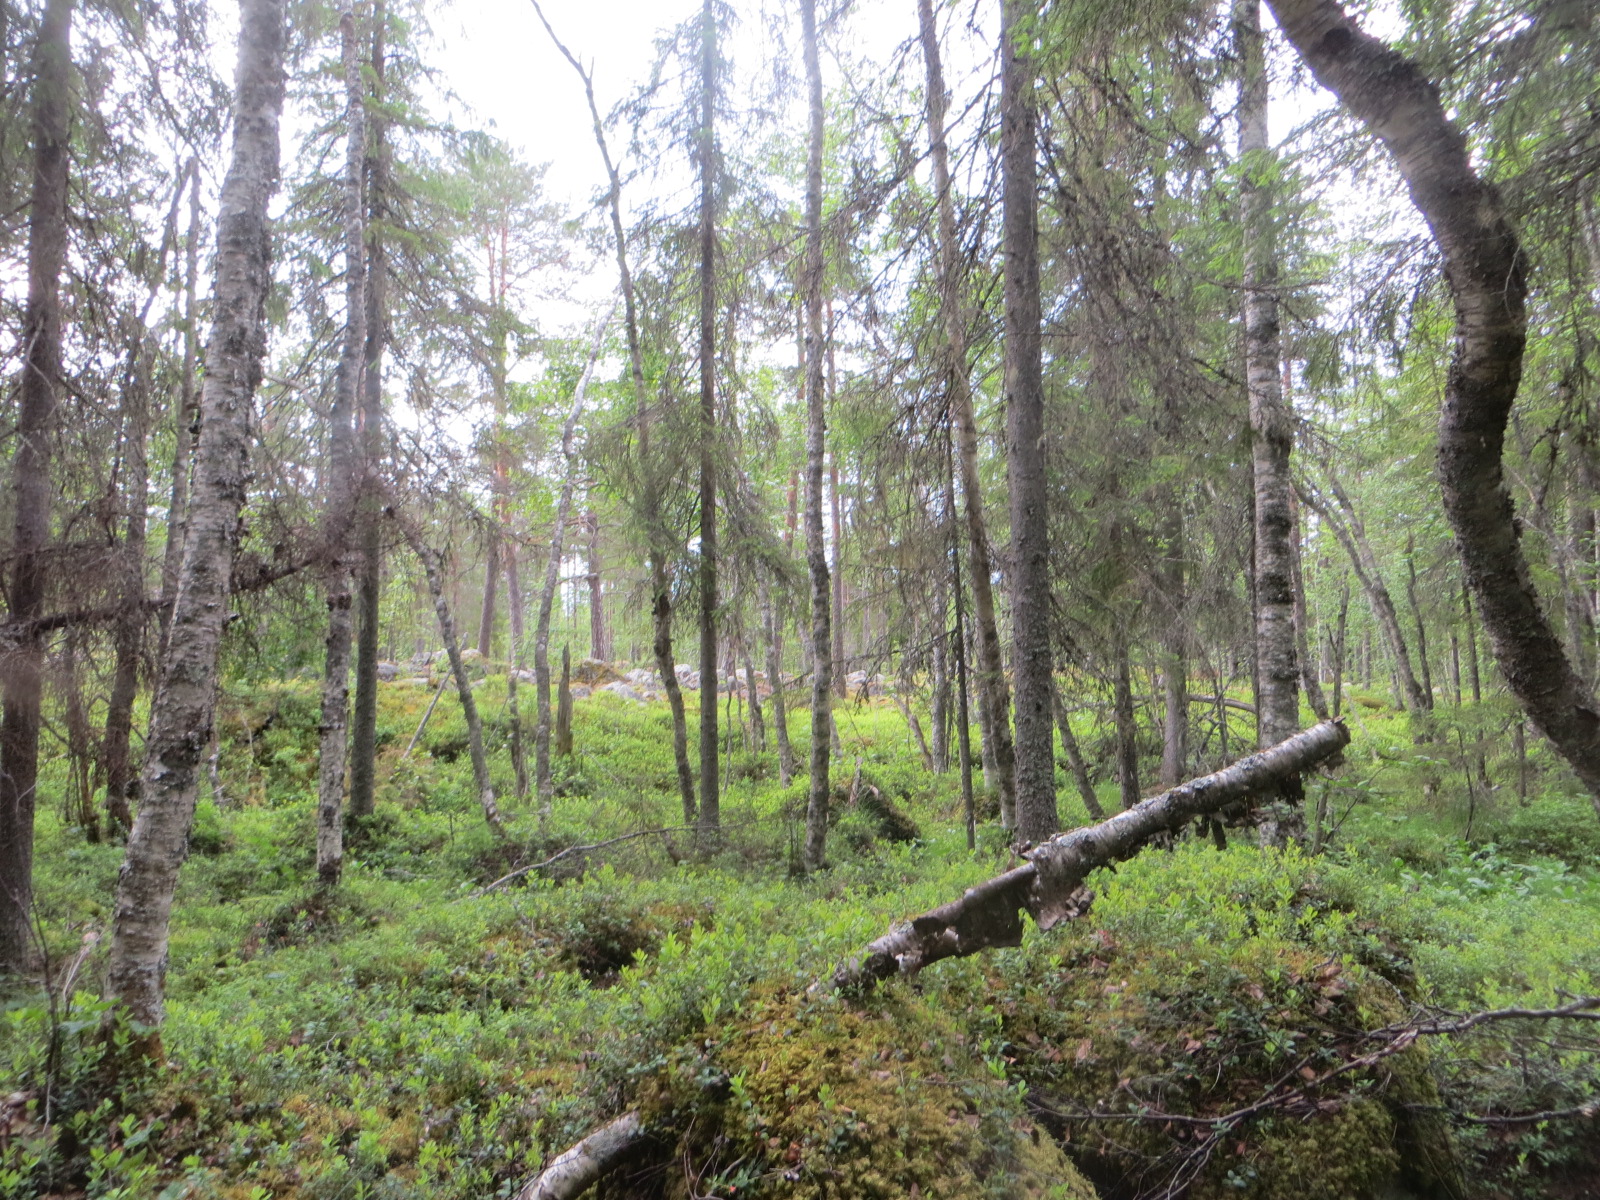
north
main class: Woodland
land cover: Spruce dominated mixed woodland
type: mire and swamp forests
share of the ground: 50 - 75 %
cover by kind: coniferous forest trees 40 %, broadleaved forest trees 30 %, shrubs 25 %, lichens and mosses 5 %
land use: Forestry
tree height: > 5 m
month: July
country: FI
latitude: 65.6092
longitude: 25.1071
